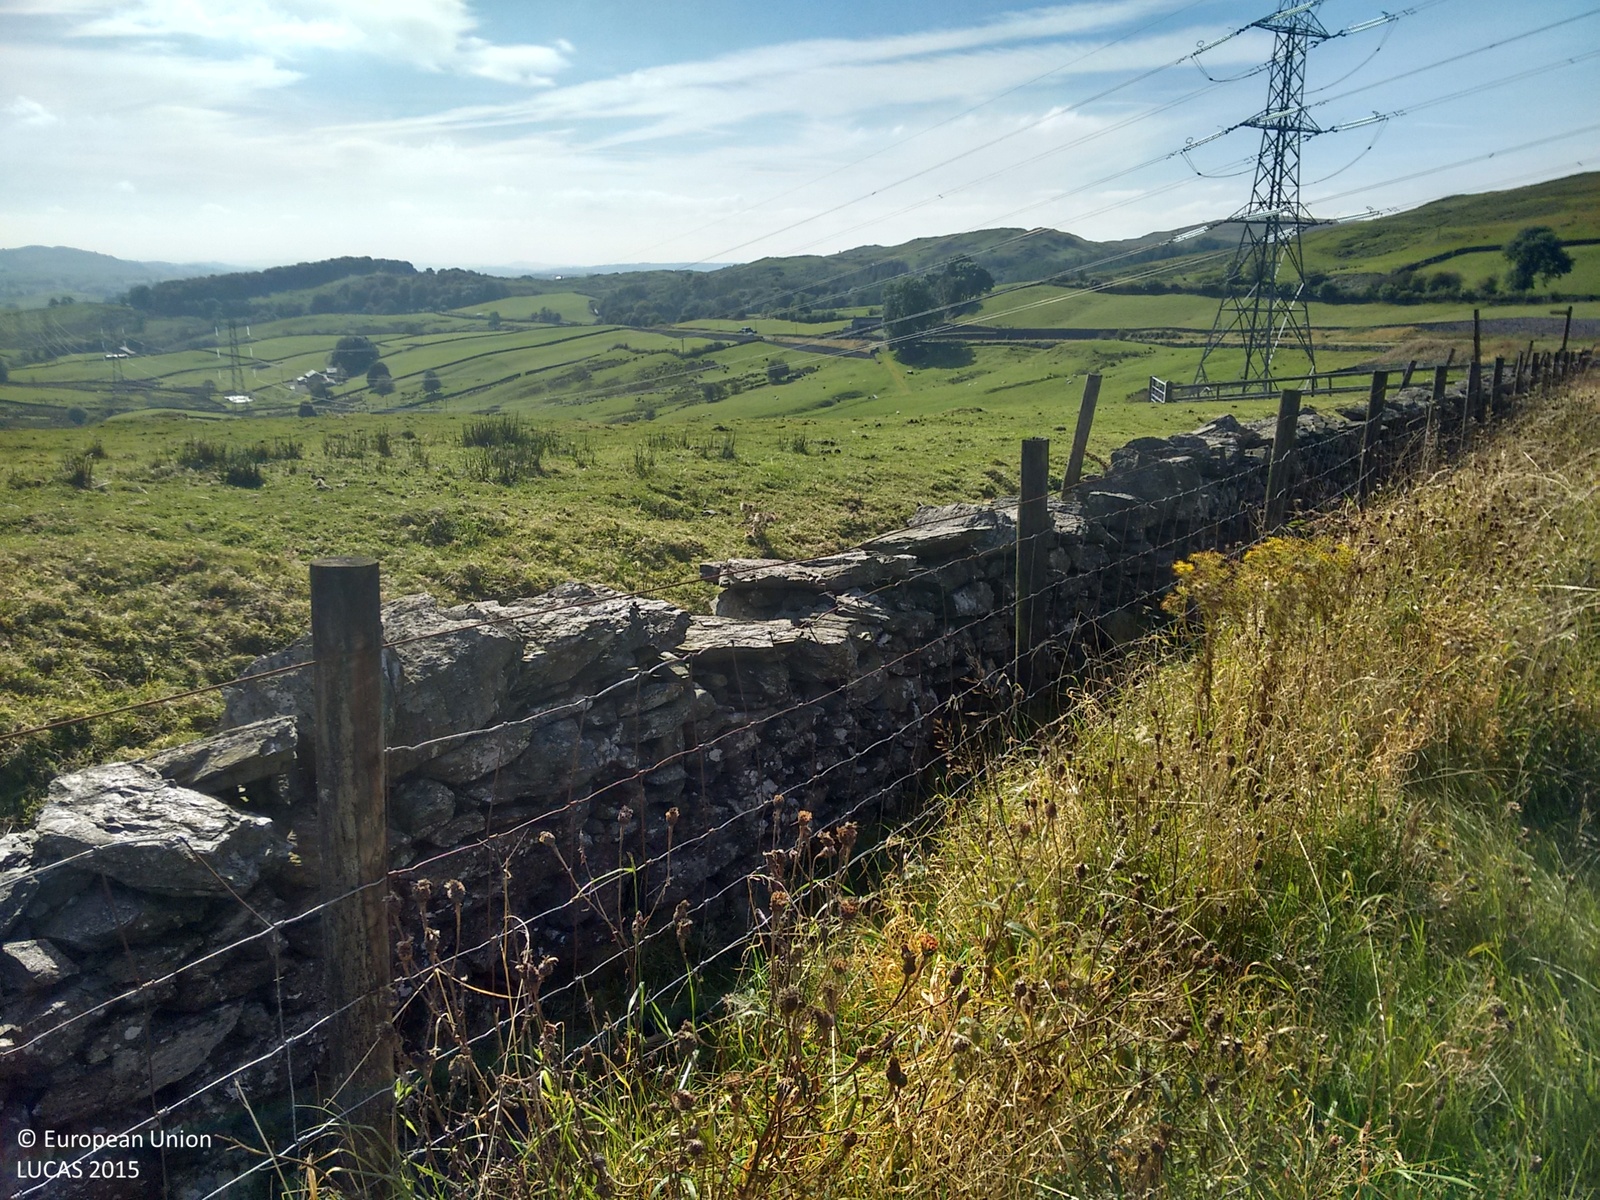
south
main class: Grassland
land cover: Grassland without tree/shrub cover
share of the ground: > 75 %
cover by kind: herbaceous plants 100 %
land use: Agriculture (excluding fallow land and kitchen gardens)
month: September
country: GB
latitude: 54.4247
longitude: -2.6905
